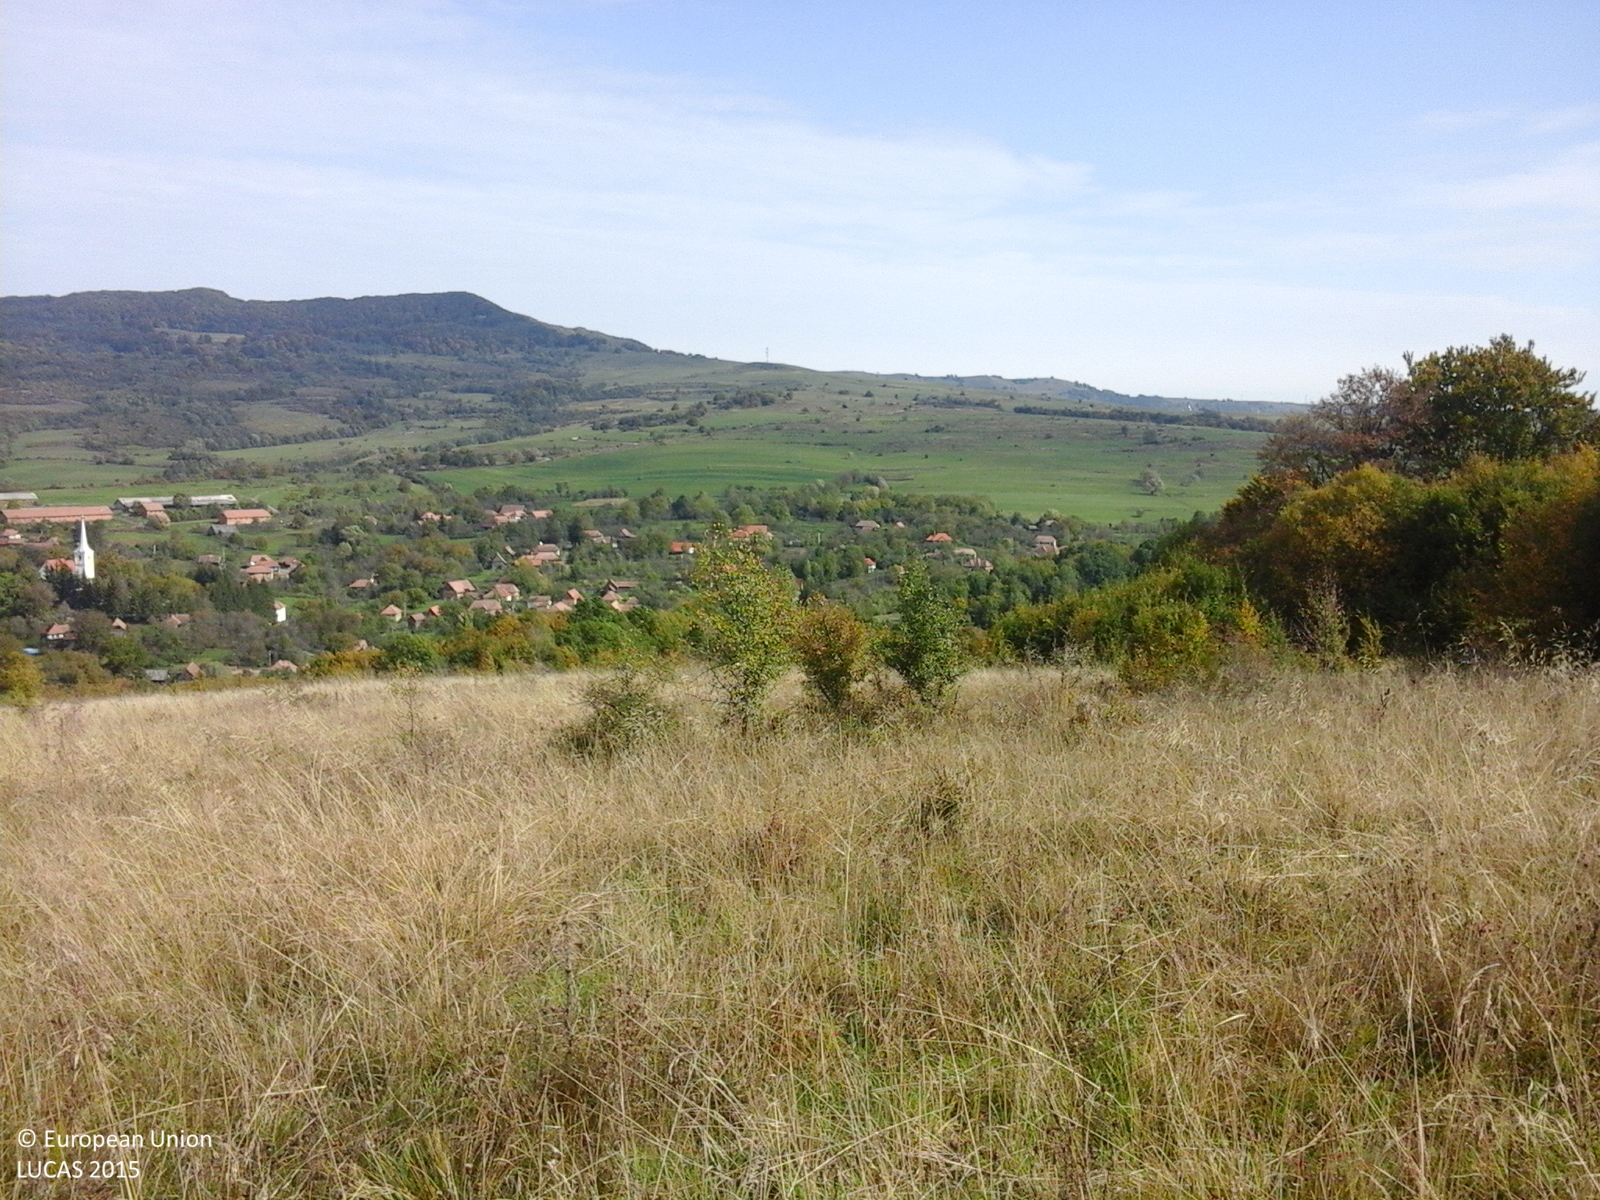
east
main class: Grassland
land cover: Grassland with sparse tree/shrub cover
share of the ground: > 75 %
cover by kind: herbaceous plants 85 %, shrubs 10 %, broadleaved forest trees 5 %
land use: Agriculture (excluding fallow land and kitchen gardens)
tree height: > 5 m
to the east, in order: Grassland with sparse tree/shrub cover; Broadleaved woodland; Grassland with sparse tree/shrub cover
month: October
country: RO
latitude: 46.4247
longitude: 25.1023
